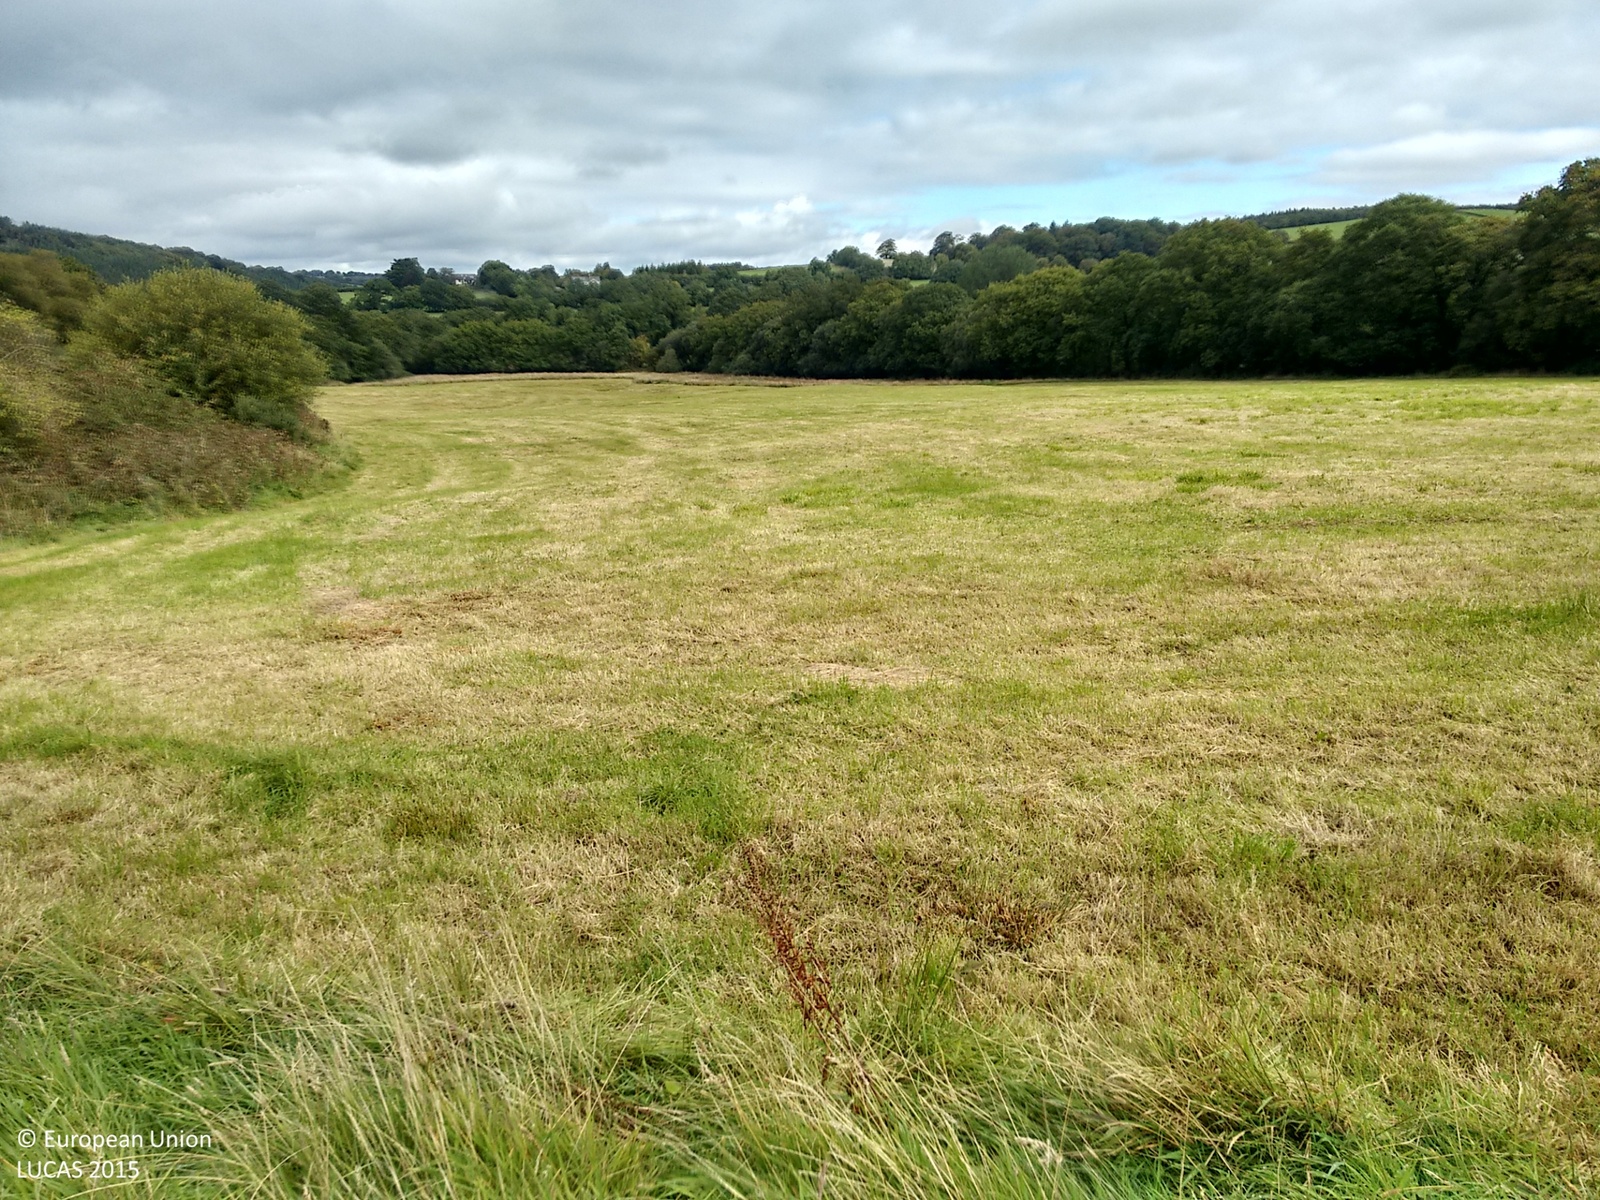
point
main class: Grassland
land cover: Grassland without tree/shrub cover
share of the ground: > 75 %
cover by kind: herbaceous plants 100 %
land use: Agriculture (excluding fallow land and kitchen gardens)
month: September
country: GB
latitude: 50.6240
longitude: -4.1909
